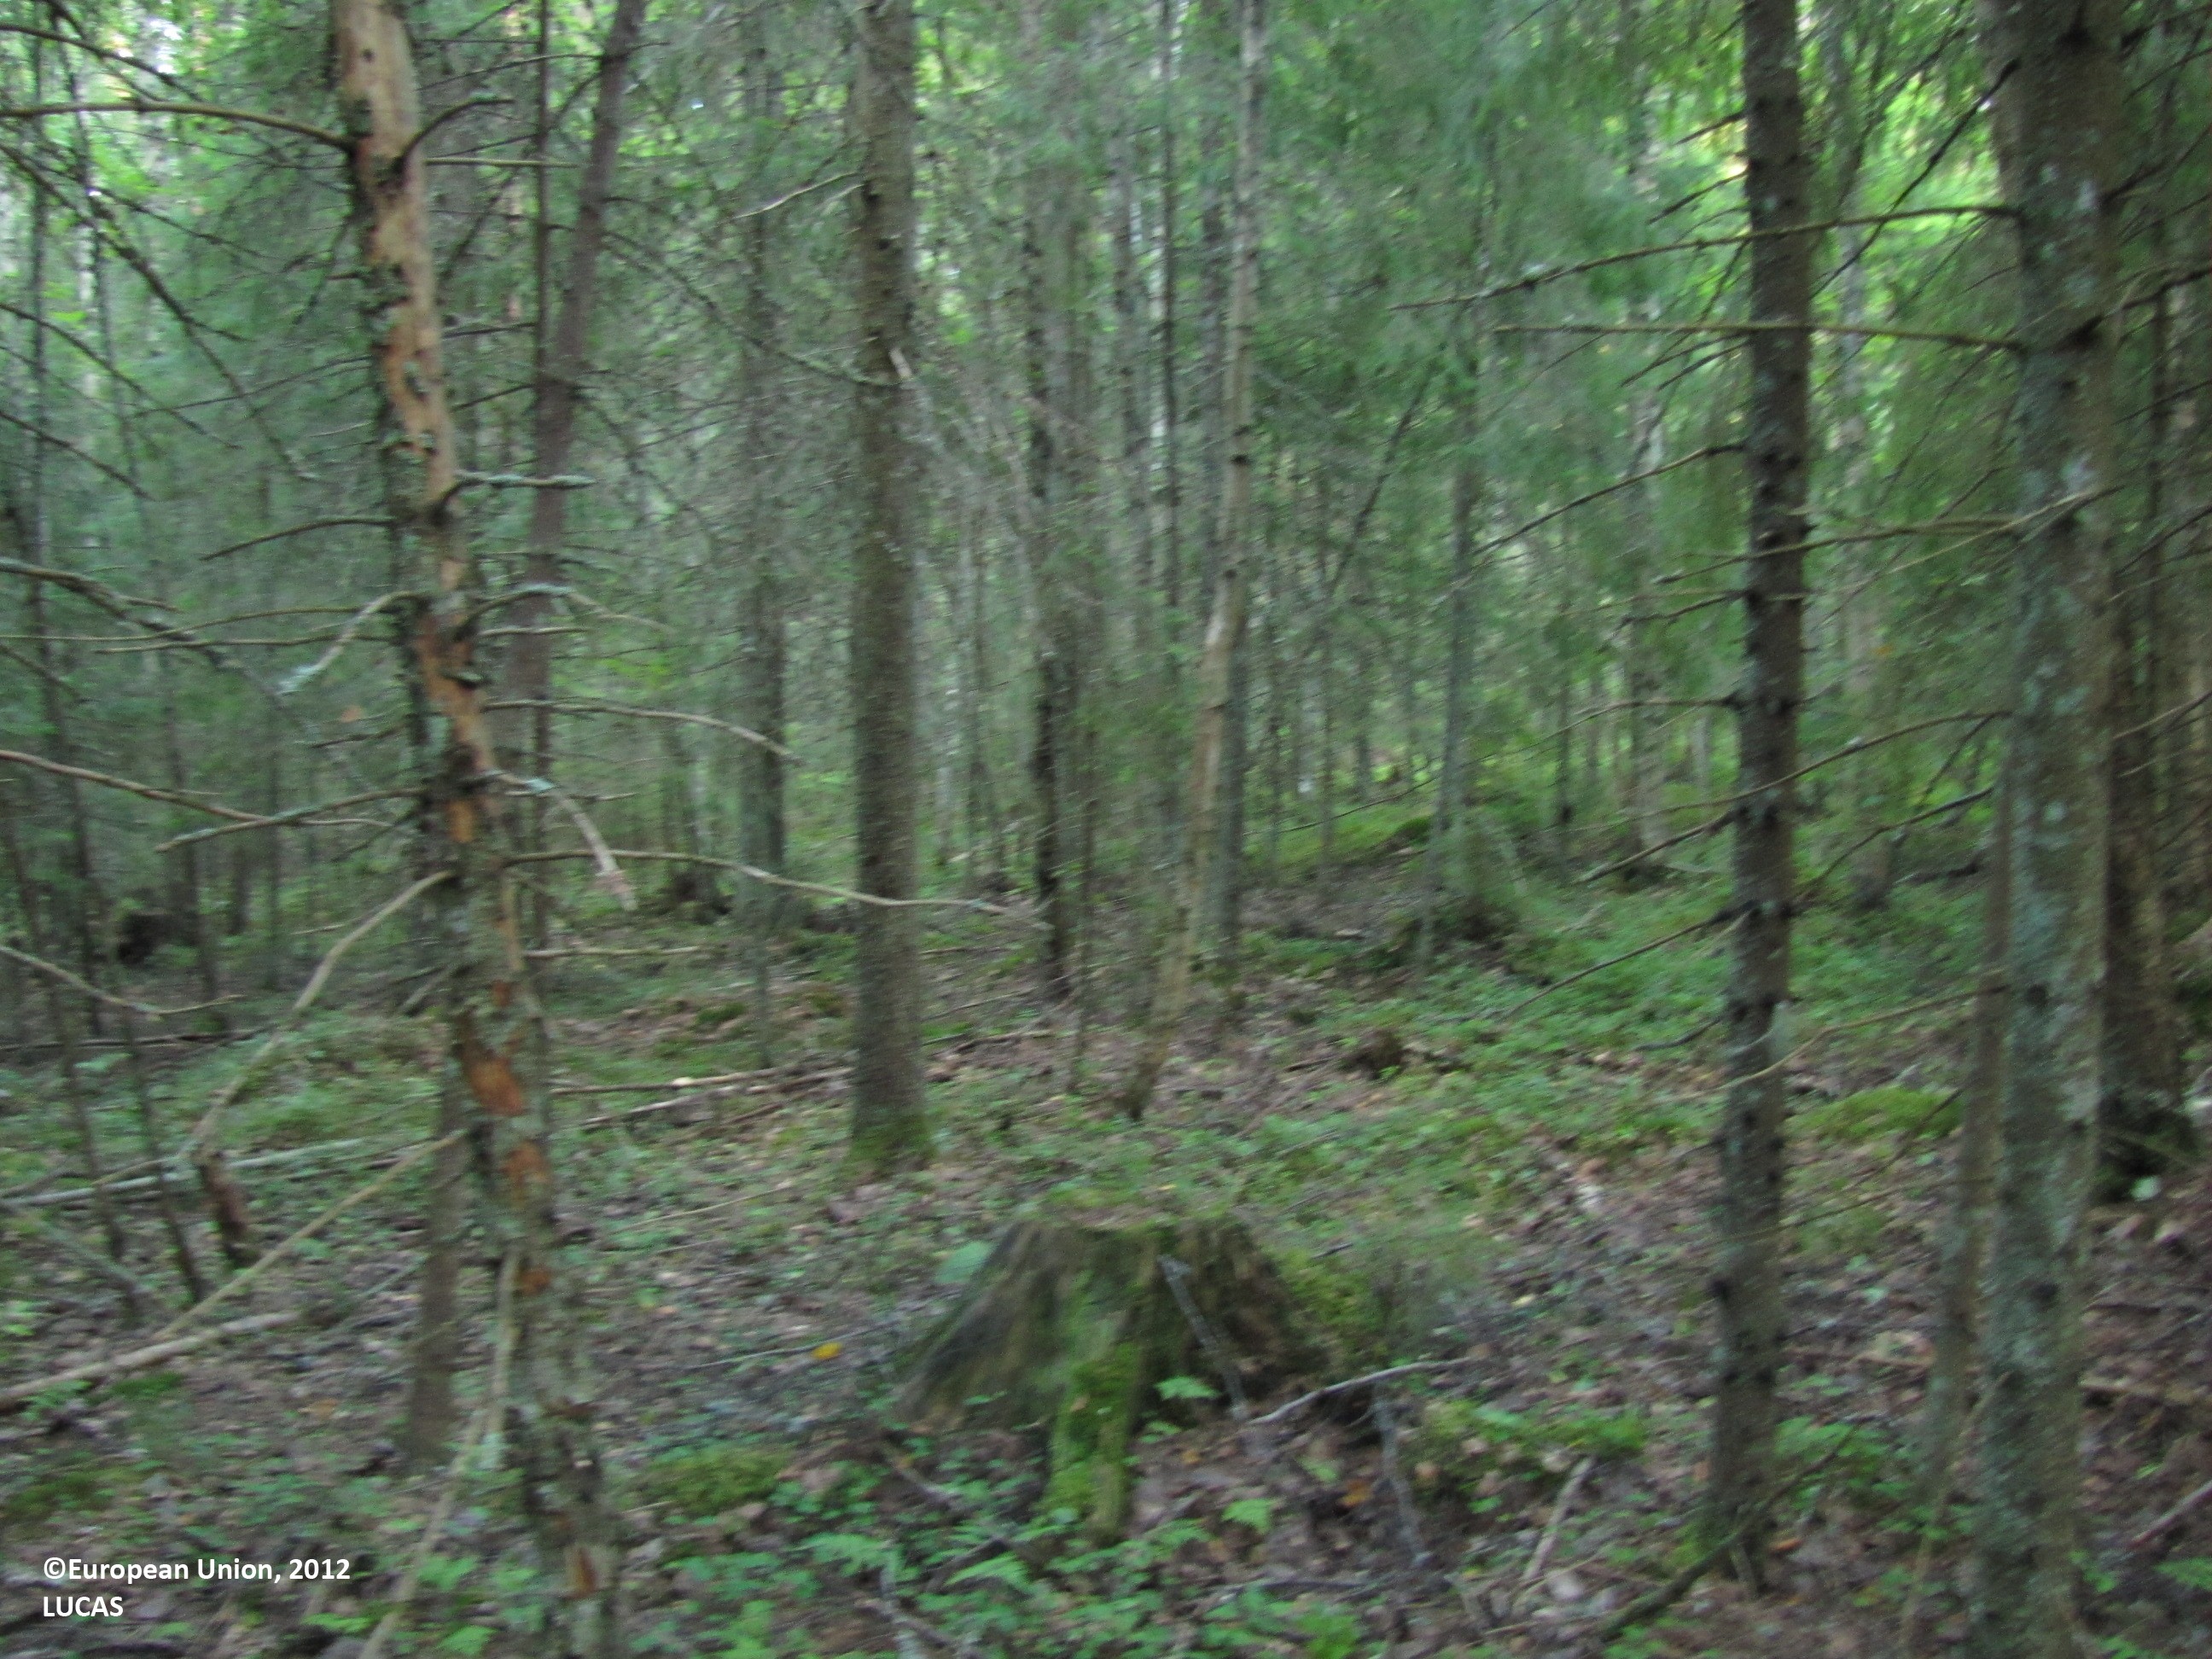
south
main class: Woodland
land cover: Spruce dominated coniferous woodland
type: boreal forest
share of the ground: > 75 %
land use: Forestry
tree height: > 5 m
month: August
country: FI
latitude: 61.7732
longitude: 22.9756
